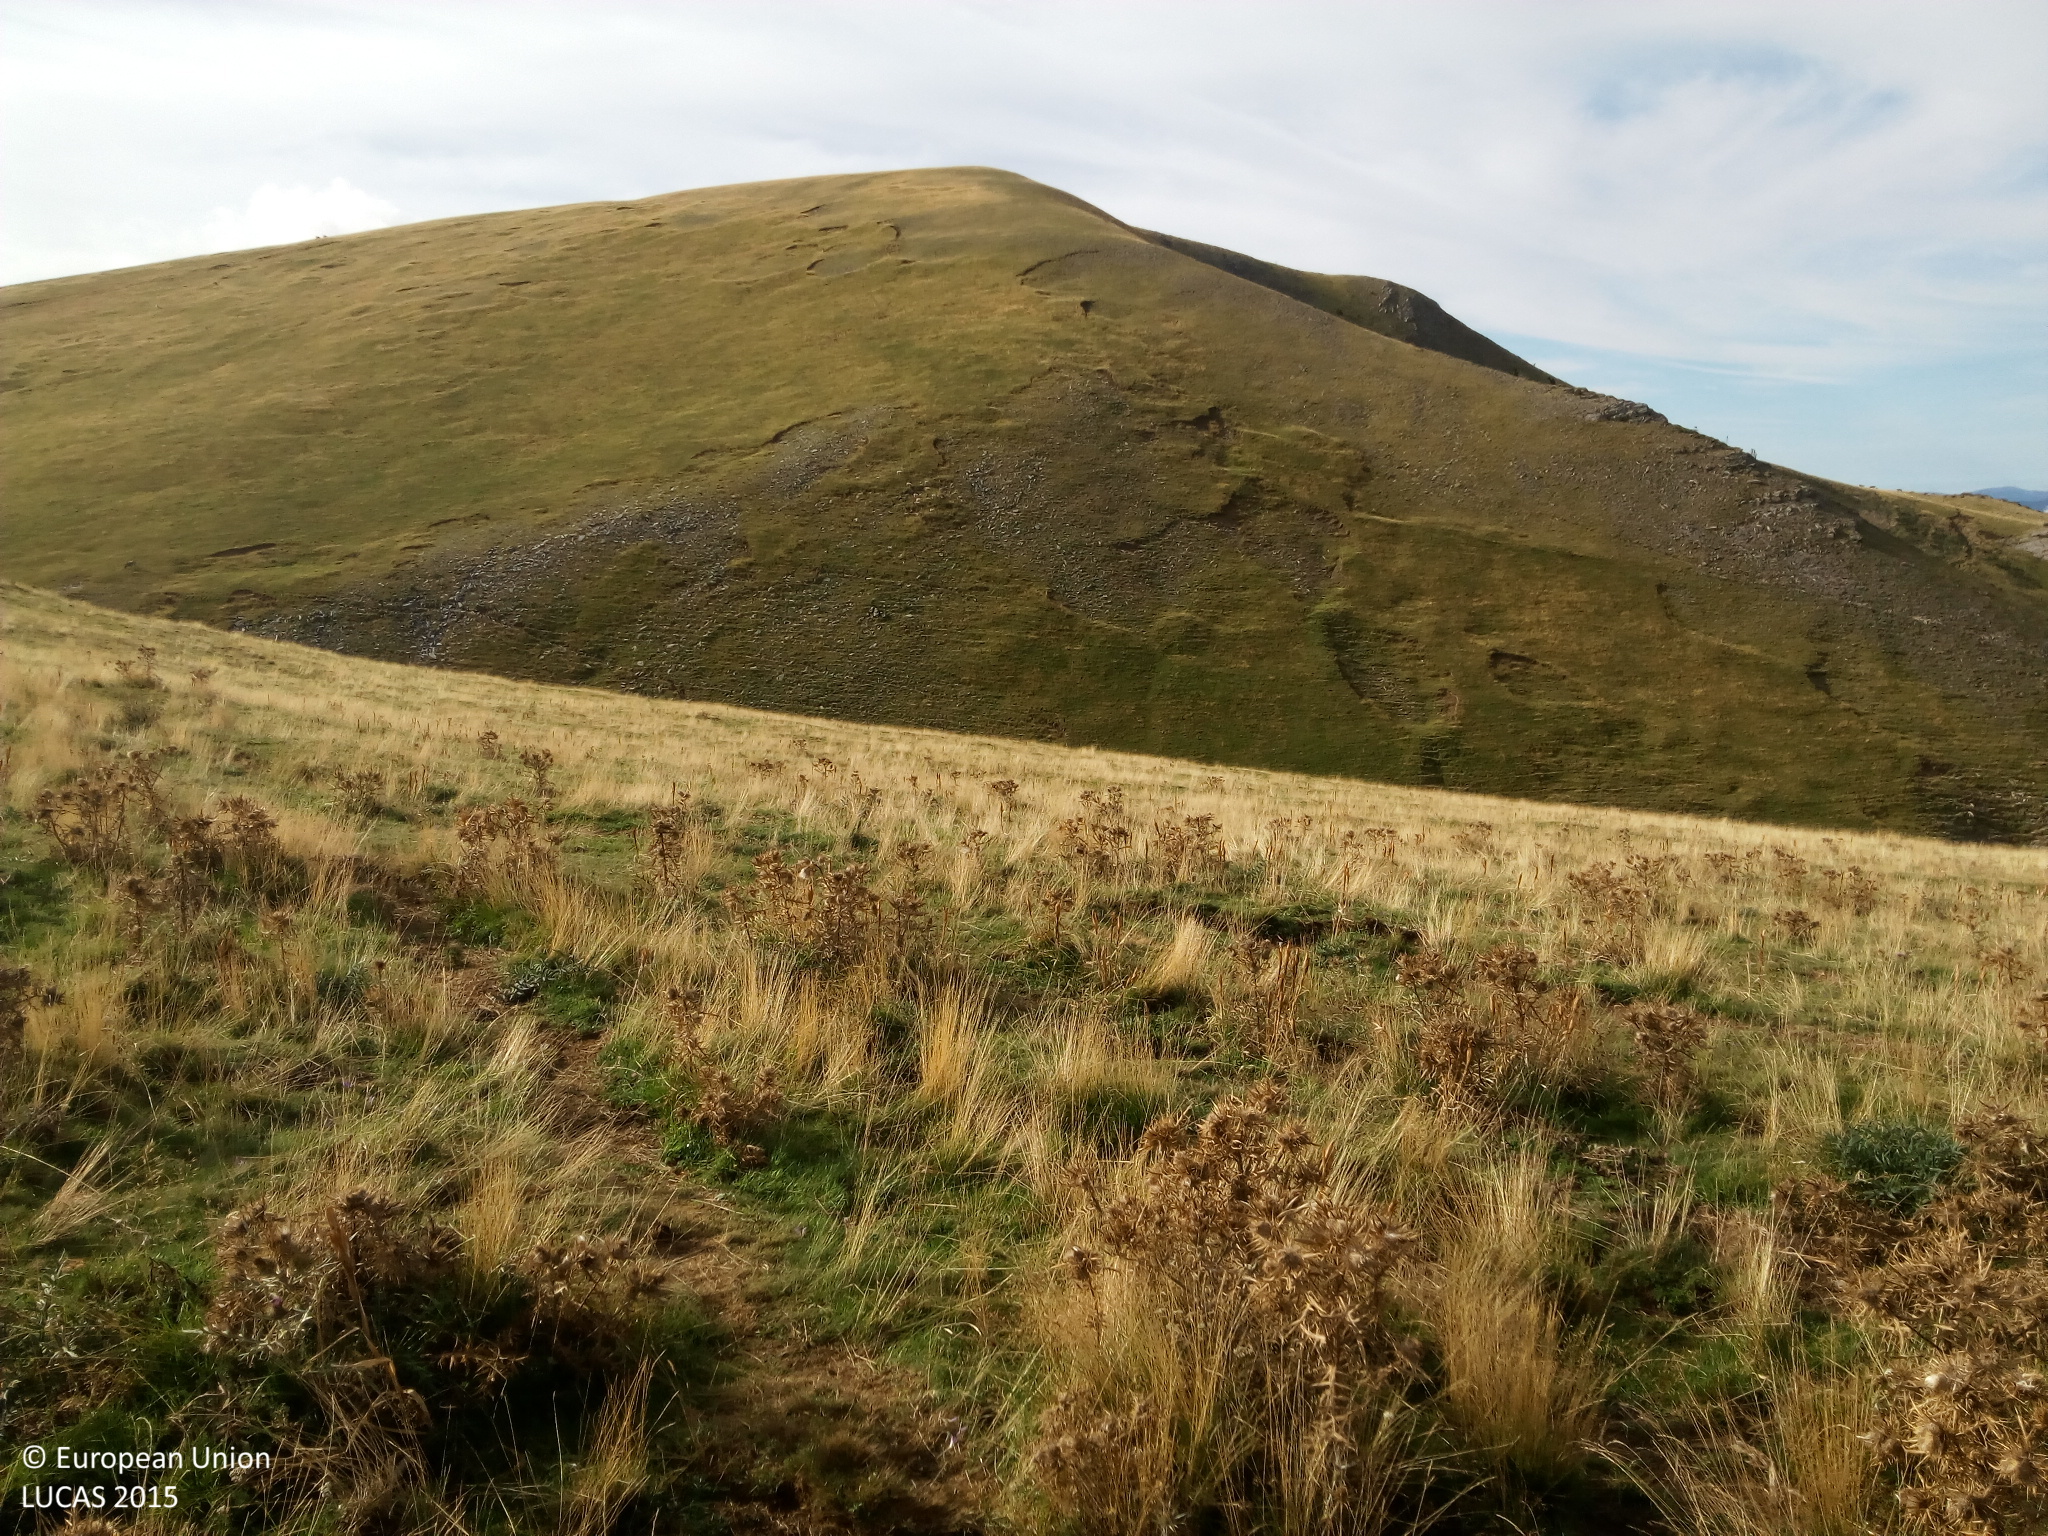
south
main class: Grassland
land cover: Grassland without tree/shrub cover
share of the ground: > 75 %
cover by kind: herbaceous plants 100 %
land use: Semi-natural and natural areas not in use
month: September
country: ES
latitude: 42.6011
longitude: 0.0680
